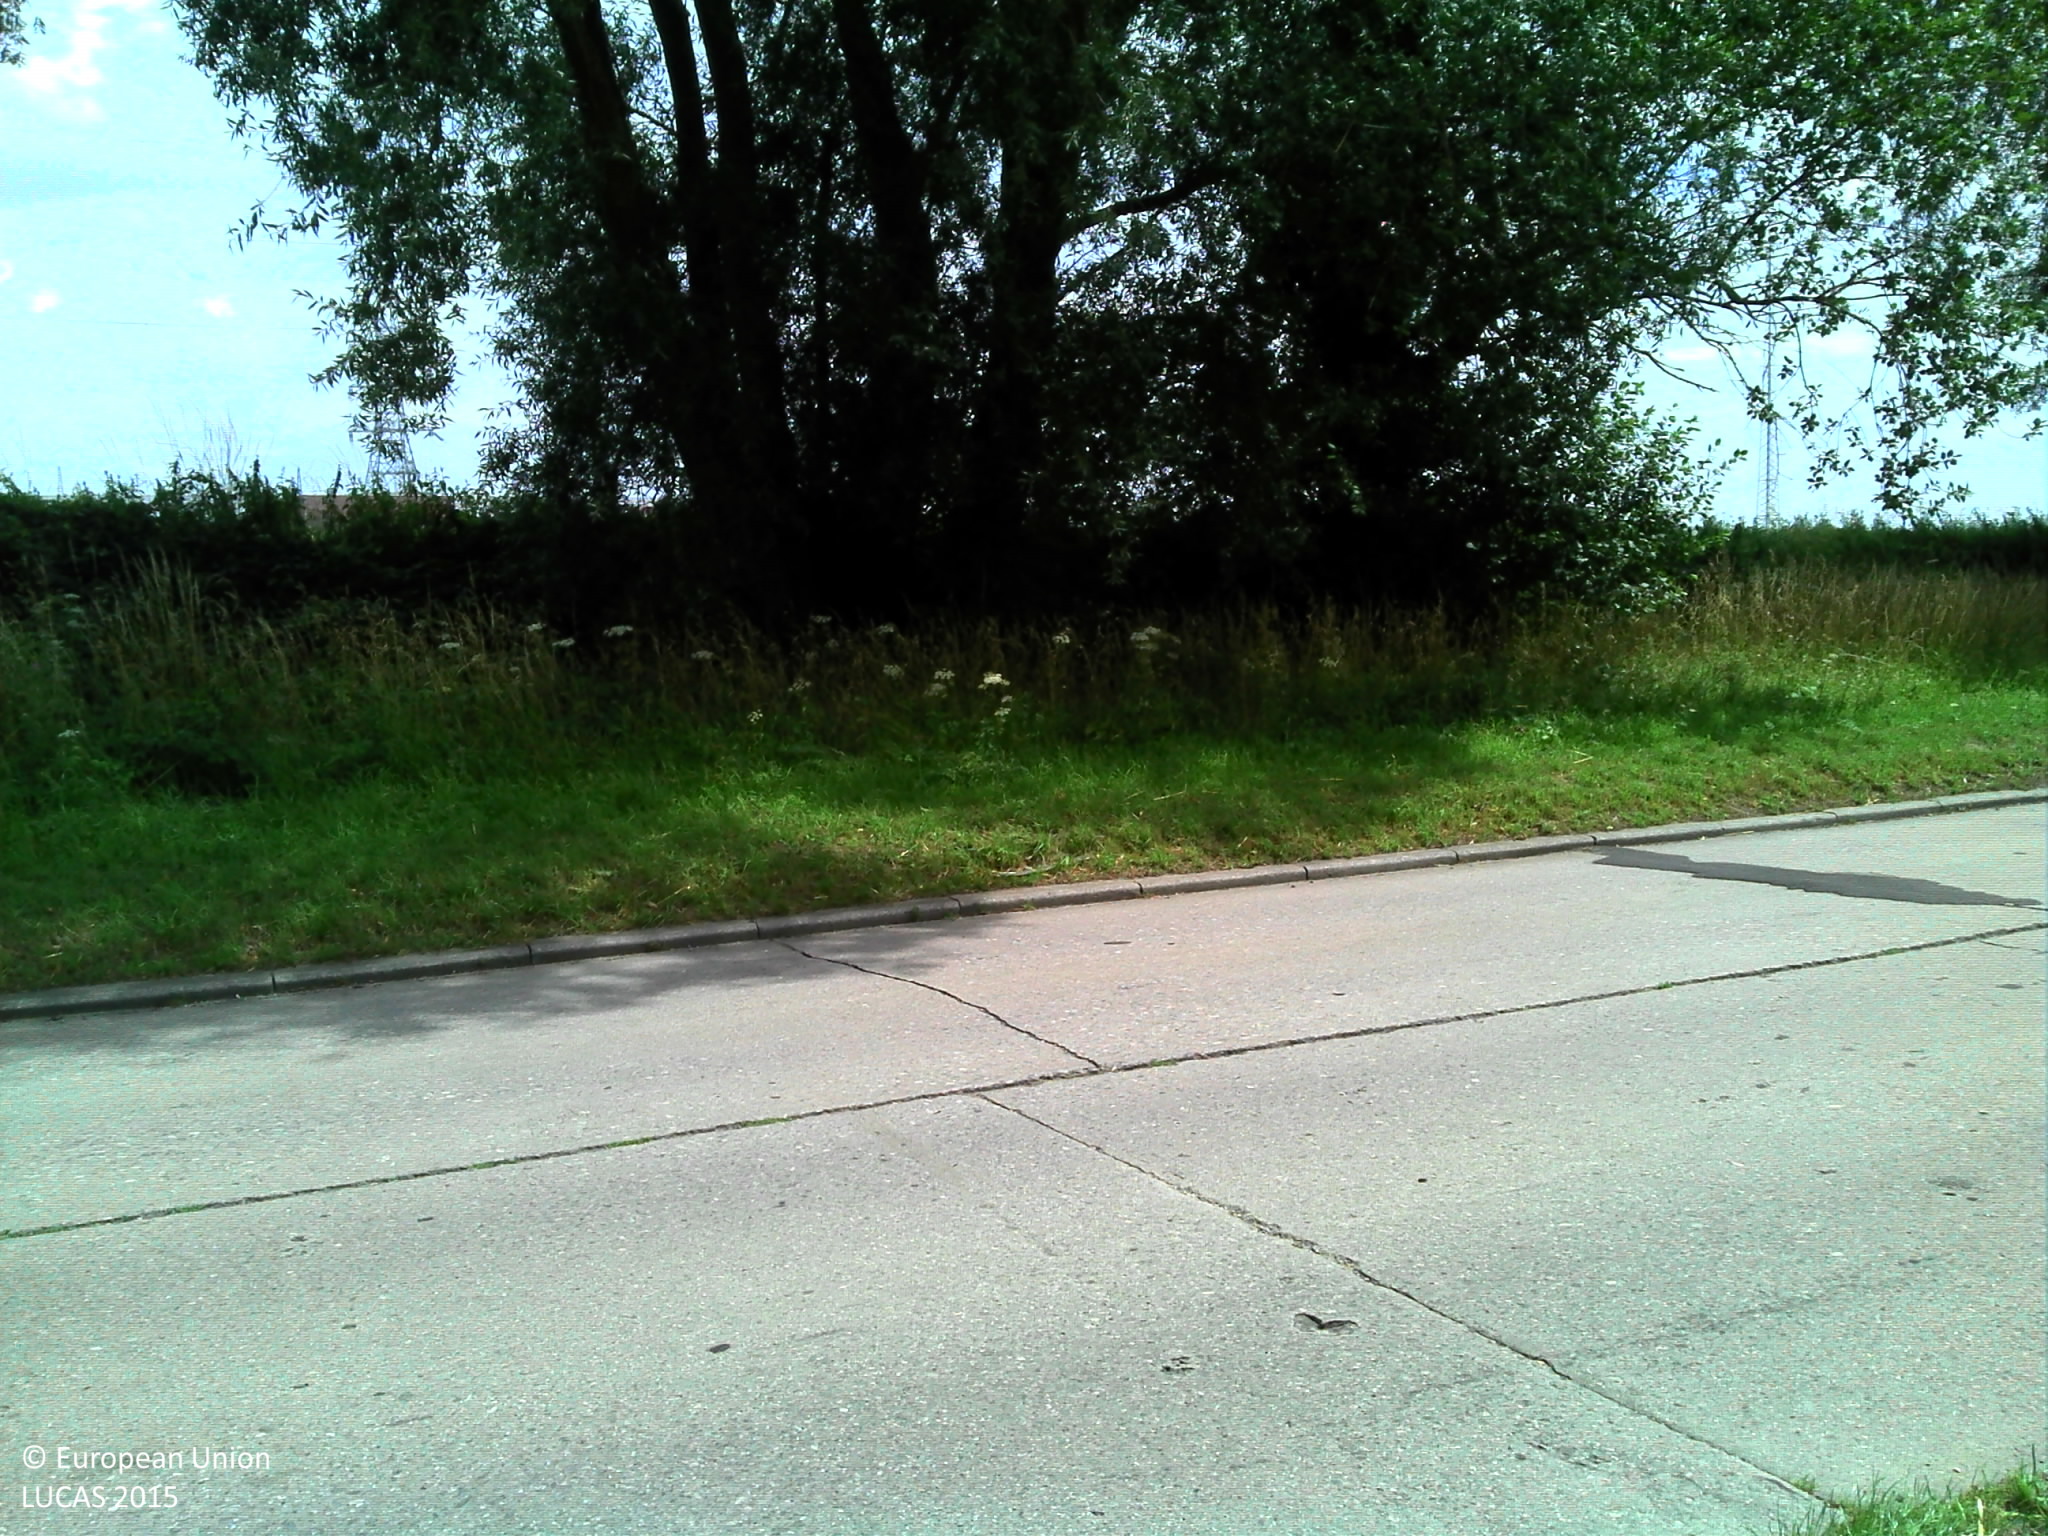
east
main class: Woodland
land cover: Broadleaved woodland
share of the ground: > 75 %
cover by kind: broadleaved forest trees 60 %, herbaceous plants 40 %
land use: Semi-natural and natural areas not in use
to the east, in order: Broadleaved woodland; Grass margins; Paved roads, cycling and walking lanes; Grass margins; Shrubland without tree cover; Lines of trees; Sugar beet; Electric lines; Sugar beet; Artificial constructions in urban areas
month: July
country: BE
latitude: 50.4945
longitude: 4.3426
